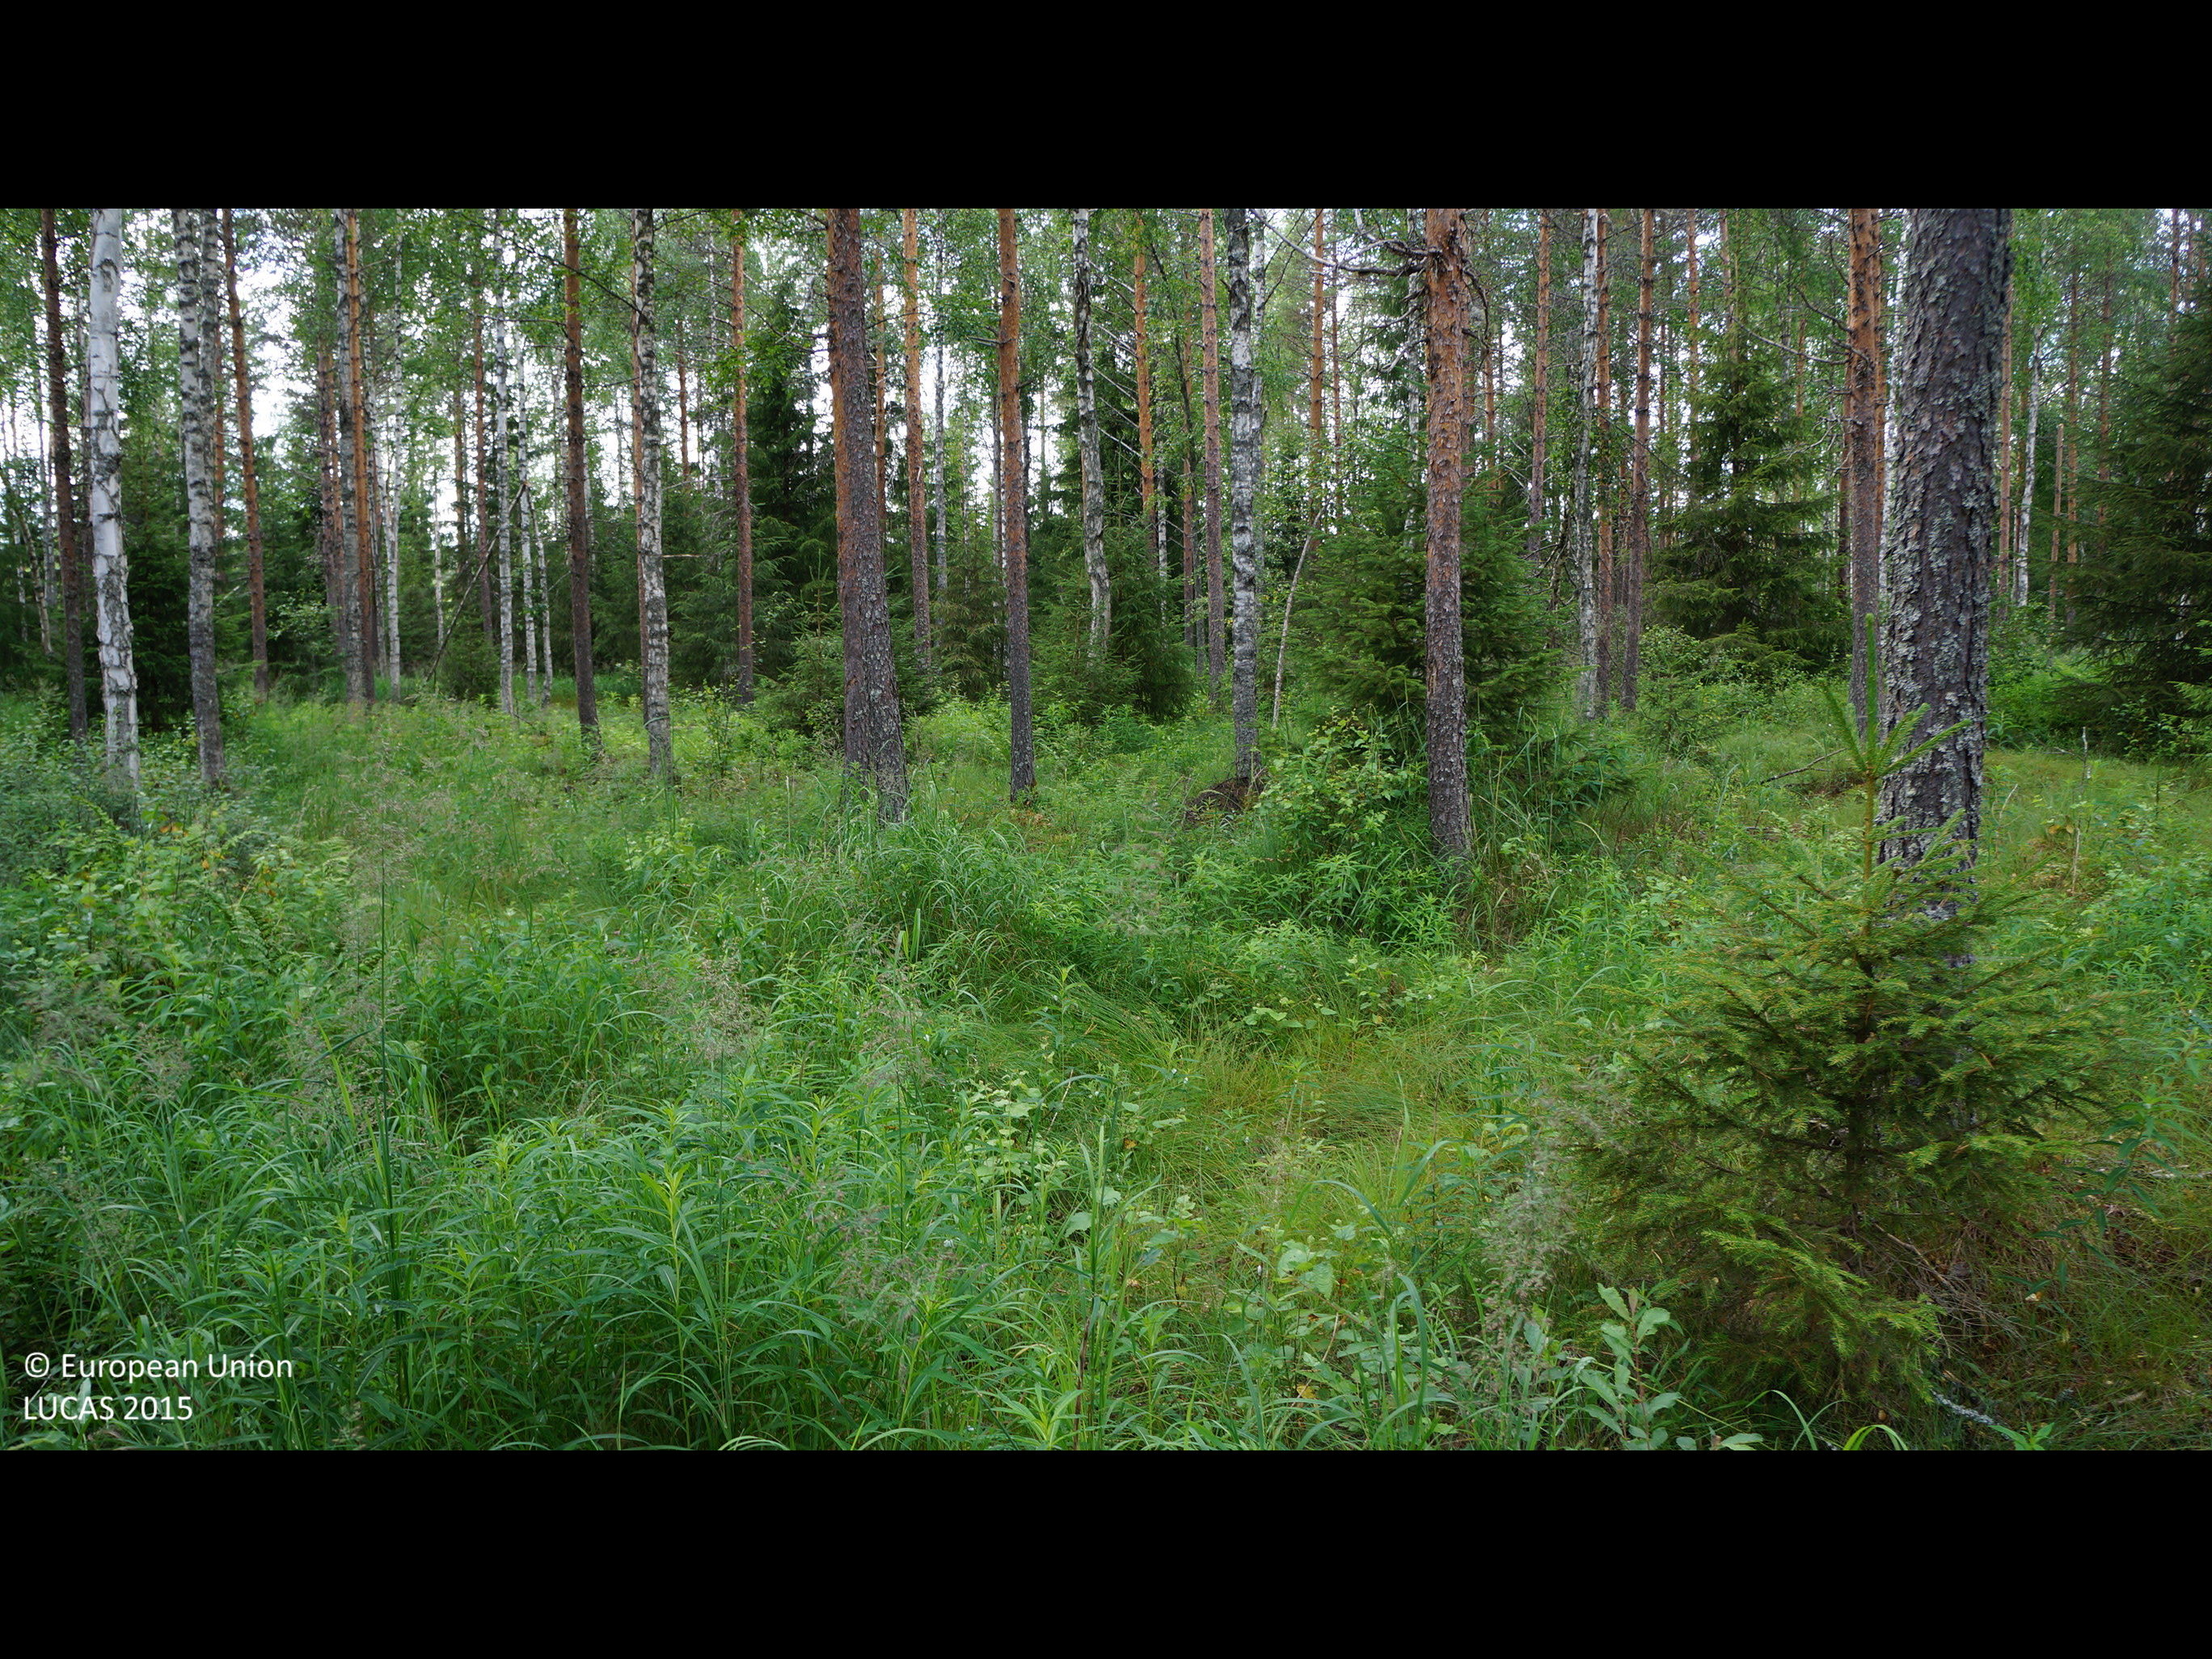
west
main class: Woodland
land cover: Pine dominated mixed woodland
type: boreal forest
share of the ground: 50 - 75 %
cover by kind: coniferous forest trees 30 %, herbaceous plants 30 %, broadleaved forest trees 20 %, shrubs 20 %
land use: Forestry
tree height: > 5 m
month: July
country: FI
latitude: 64.0157
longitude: 24.3717
